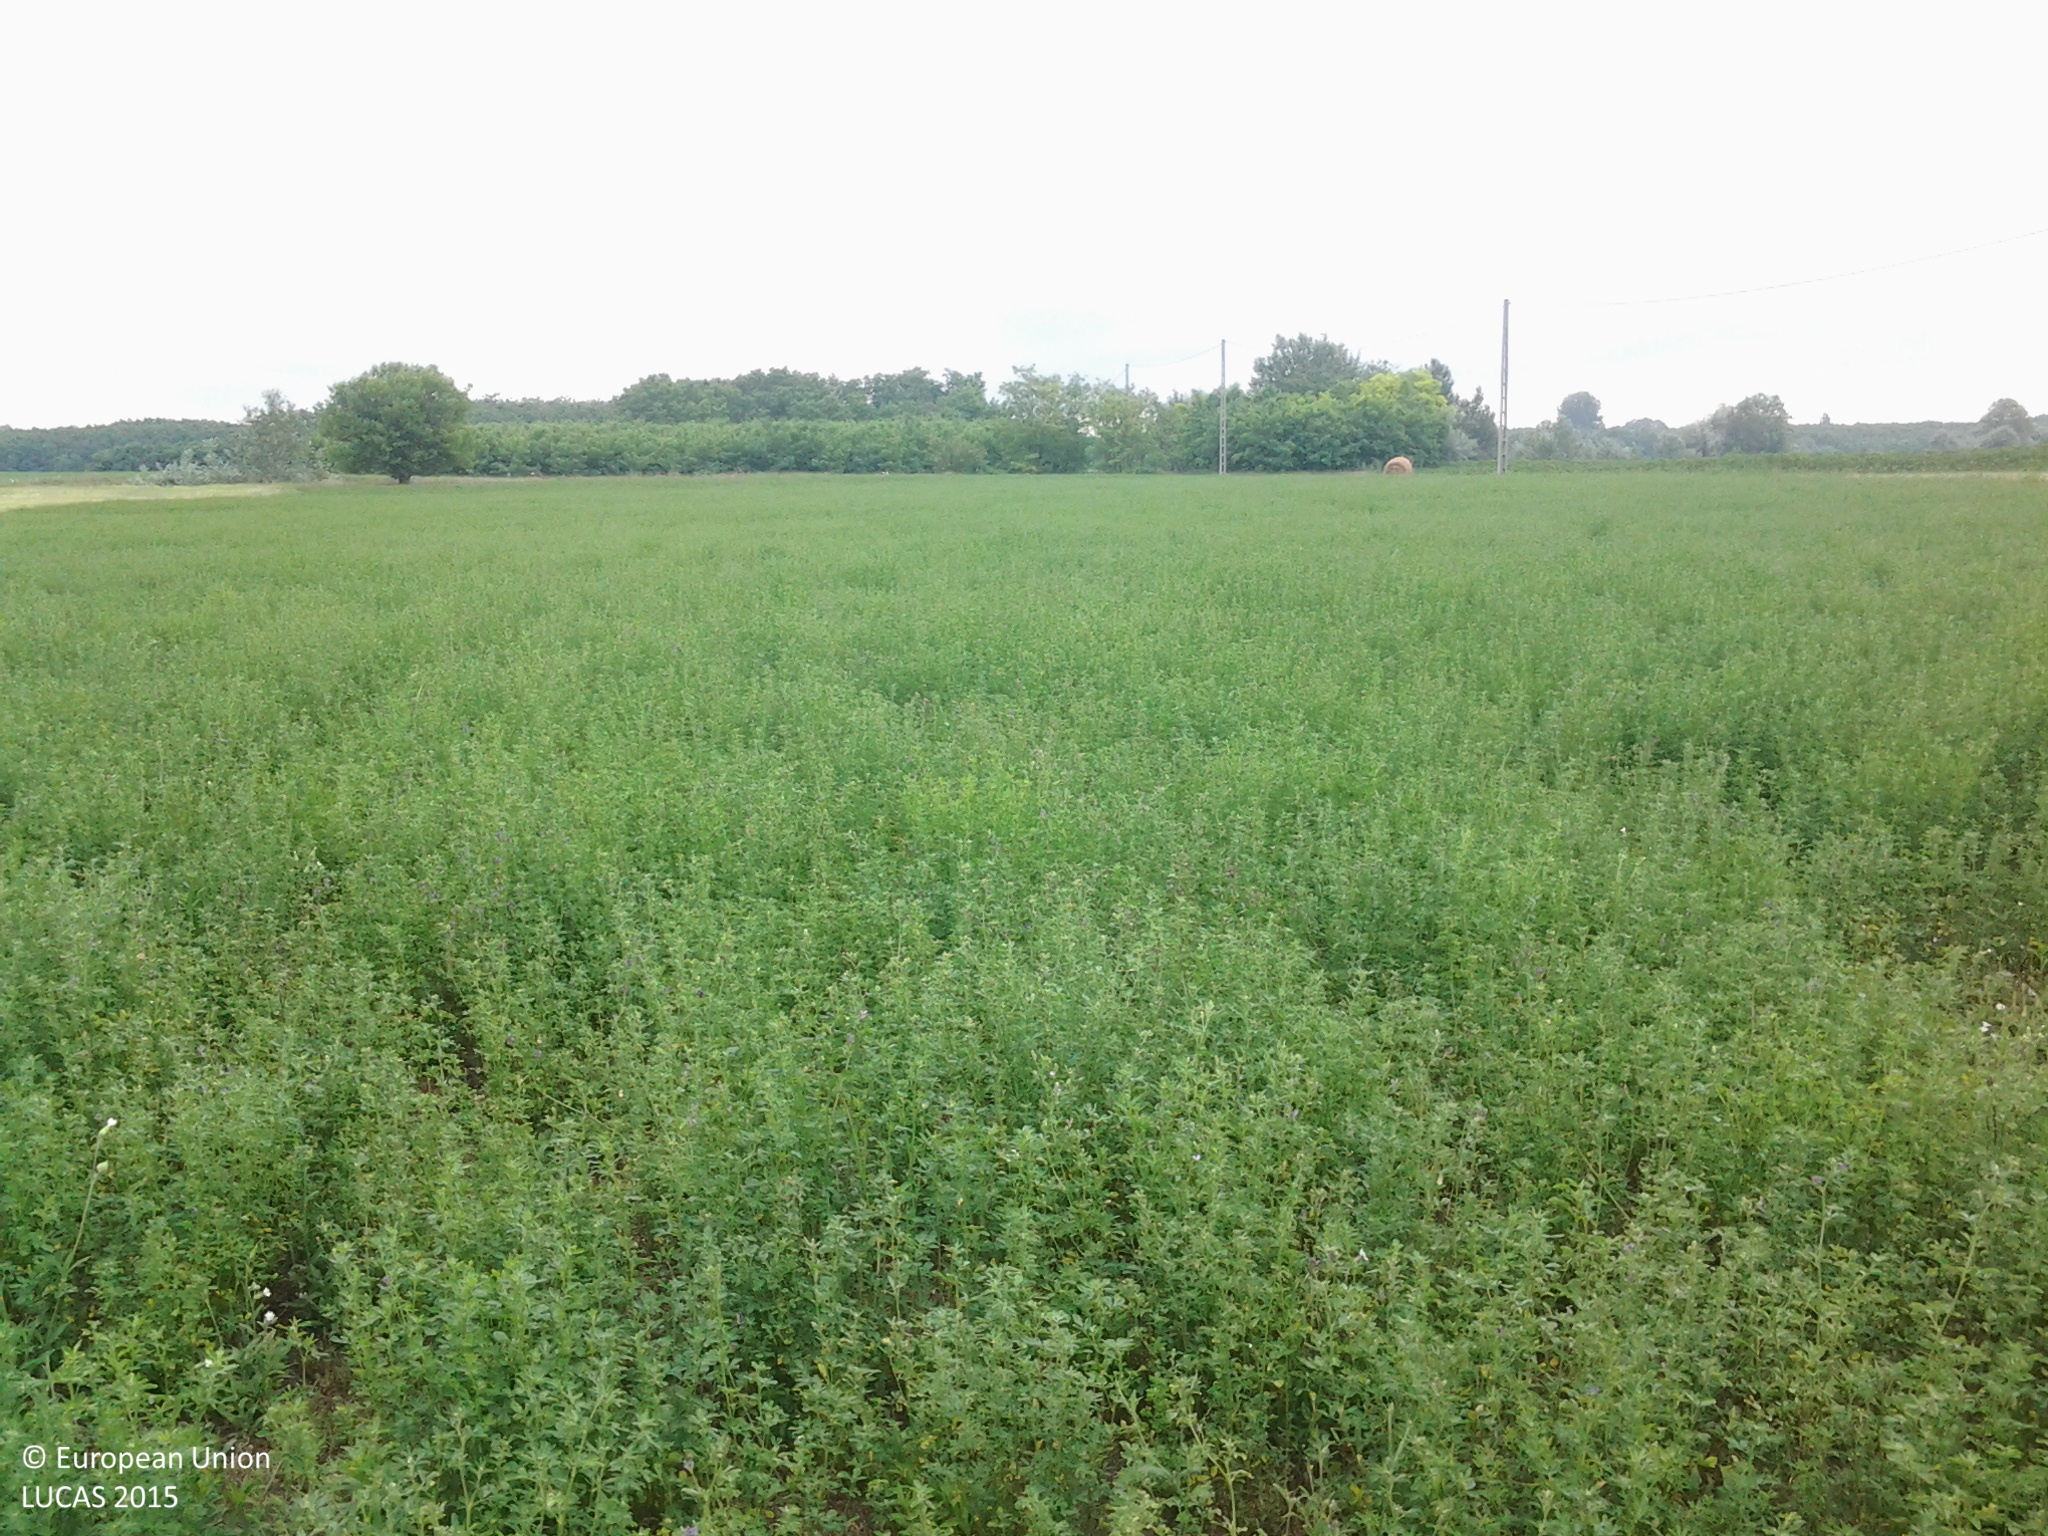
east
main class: Cropland
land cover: Lucerne
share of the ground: > 75 %
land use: Agriculture (excluding fallow land and kitchen gardens)
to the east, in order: Lucerne; Grass margins; Electric lines; Tracks; Grassland without tree/shrub cover; Sunflower
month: June
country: HU
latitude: 47.0008
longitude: 19.6608
